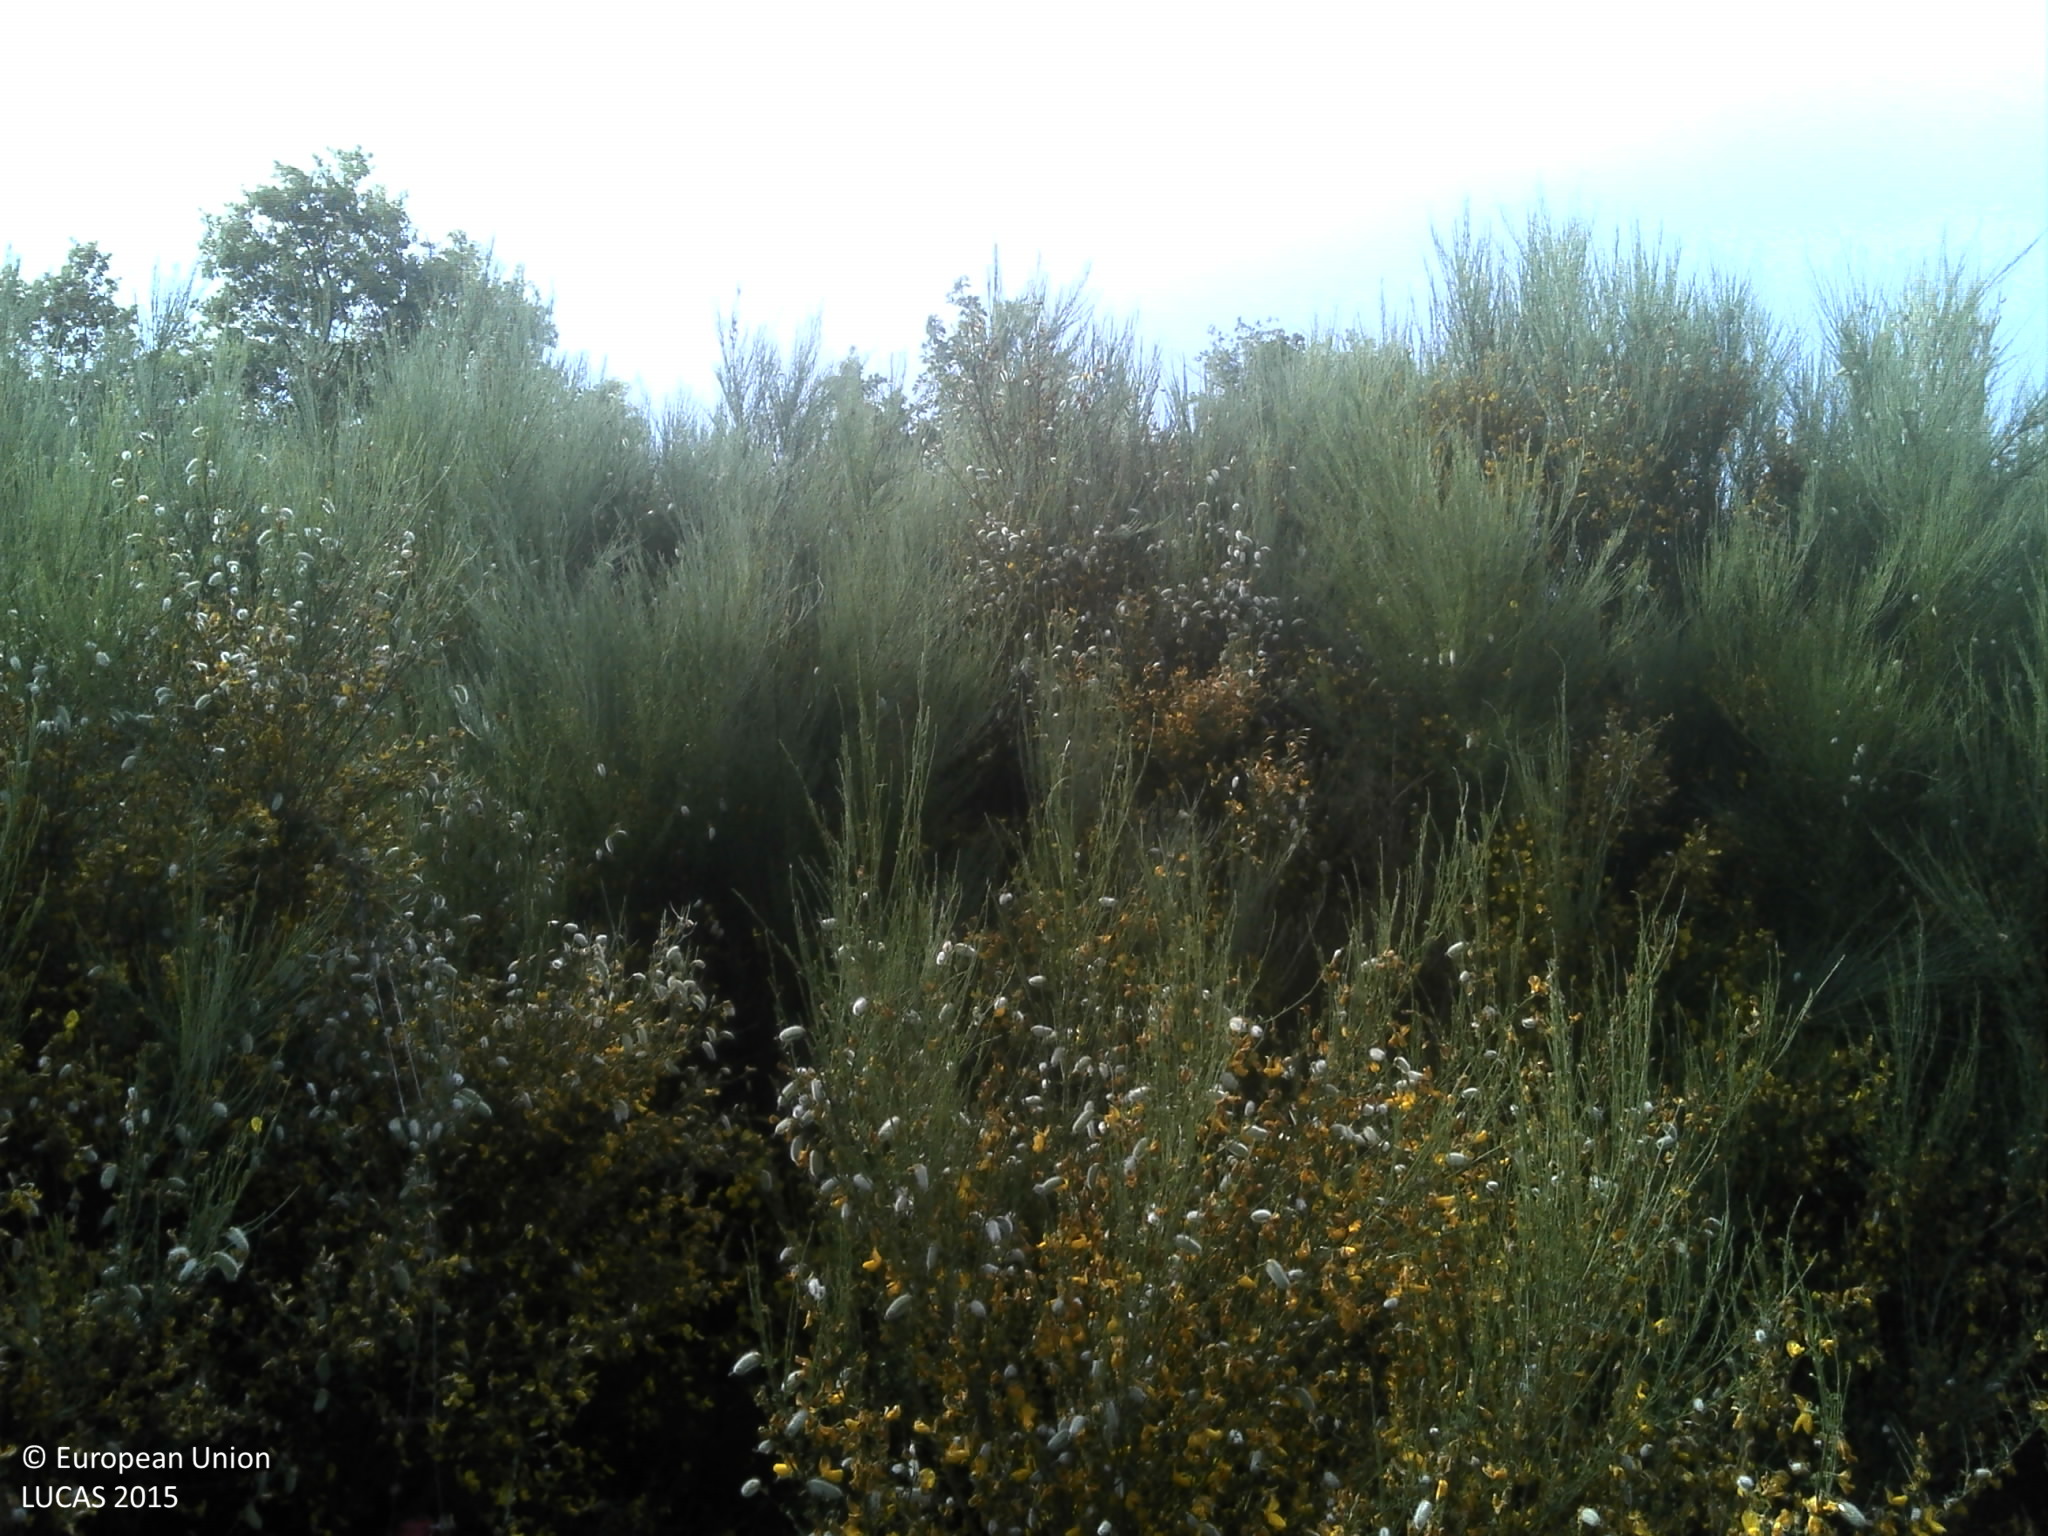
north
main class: Shrubland
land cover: Shrubland with sparse tree cover
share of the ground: 50 - 75 %
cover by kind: shrubs 75 %, unconsolidated bare surface 10 %, broadleaved forest trees 5 %, herbaceous plants 5 %
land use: Abandoned areas
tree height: < 5 m
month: June
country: PT
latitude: 40.3947
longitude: -7.1000
